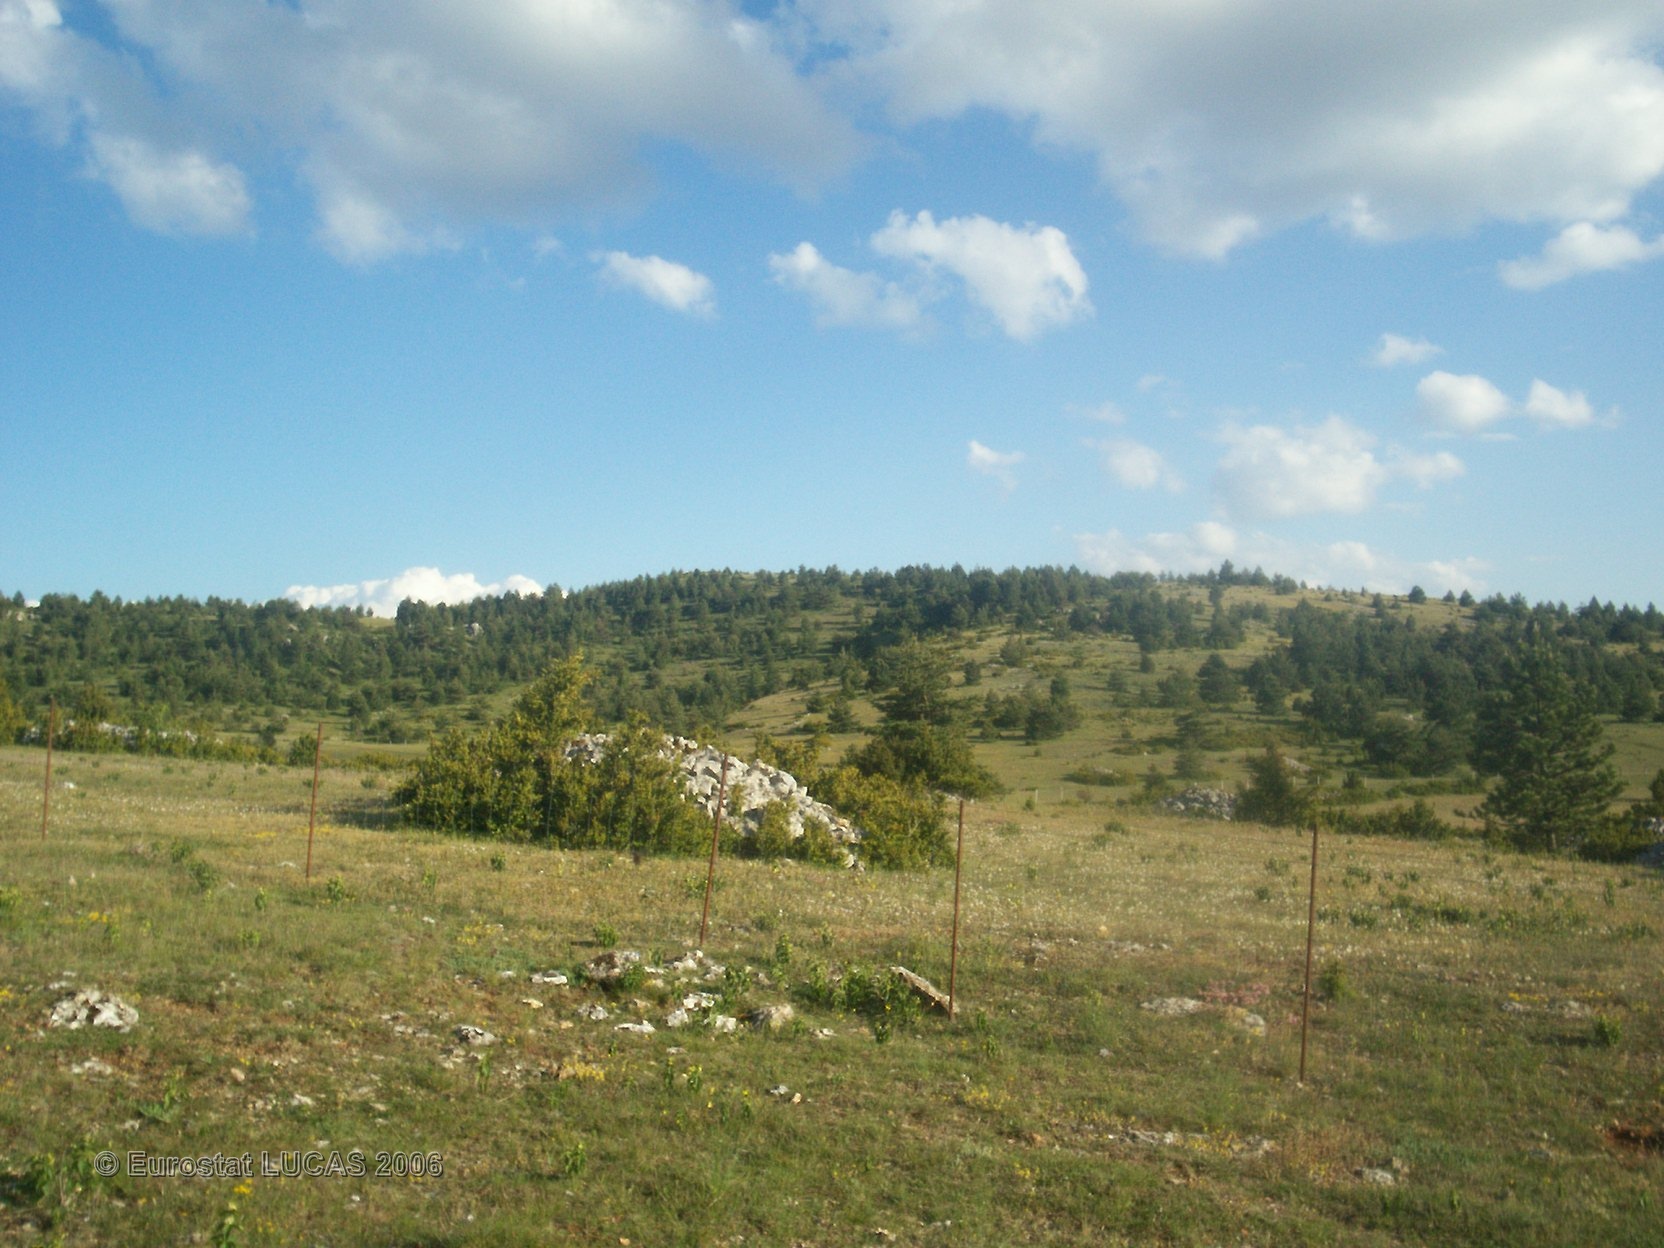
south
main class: Grassland
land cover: Grassland without tree/shrub cover
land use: Agriculture (excluding fallow land and kitchen gardens)
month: June
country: FR
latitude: 44.3243
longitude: 3.4477
